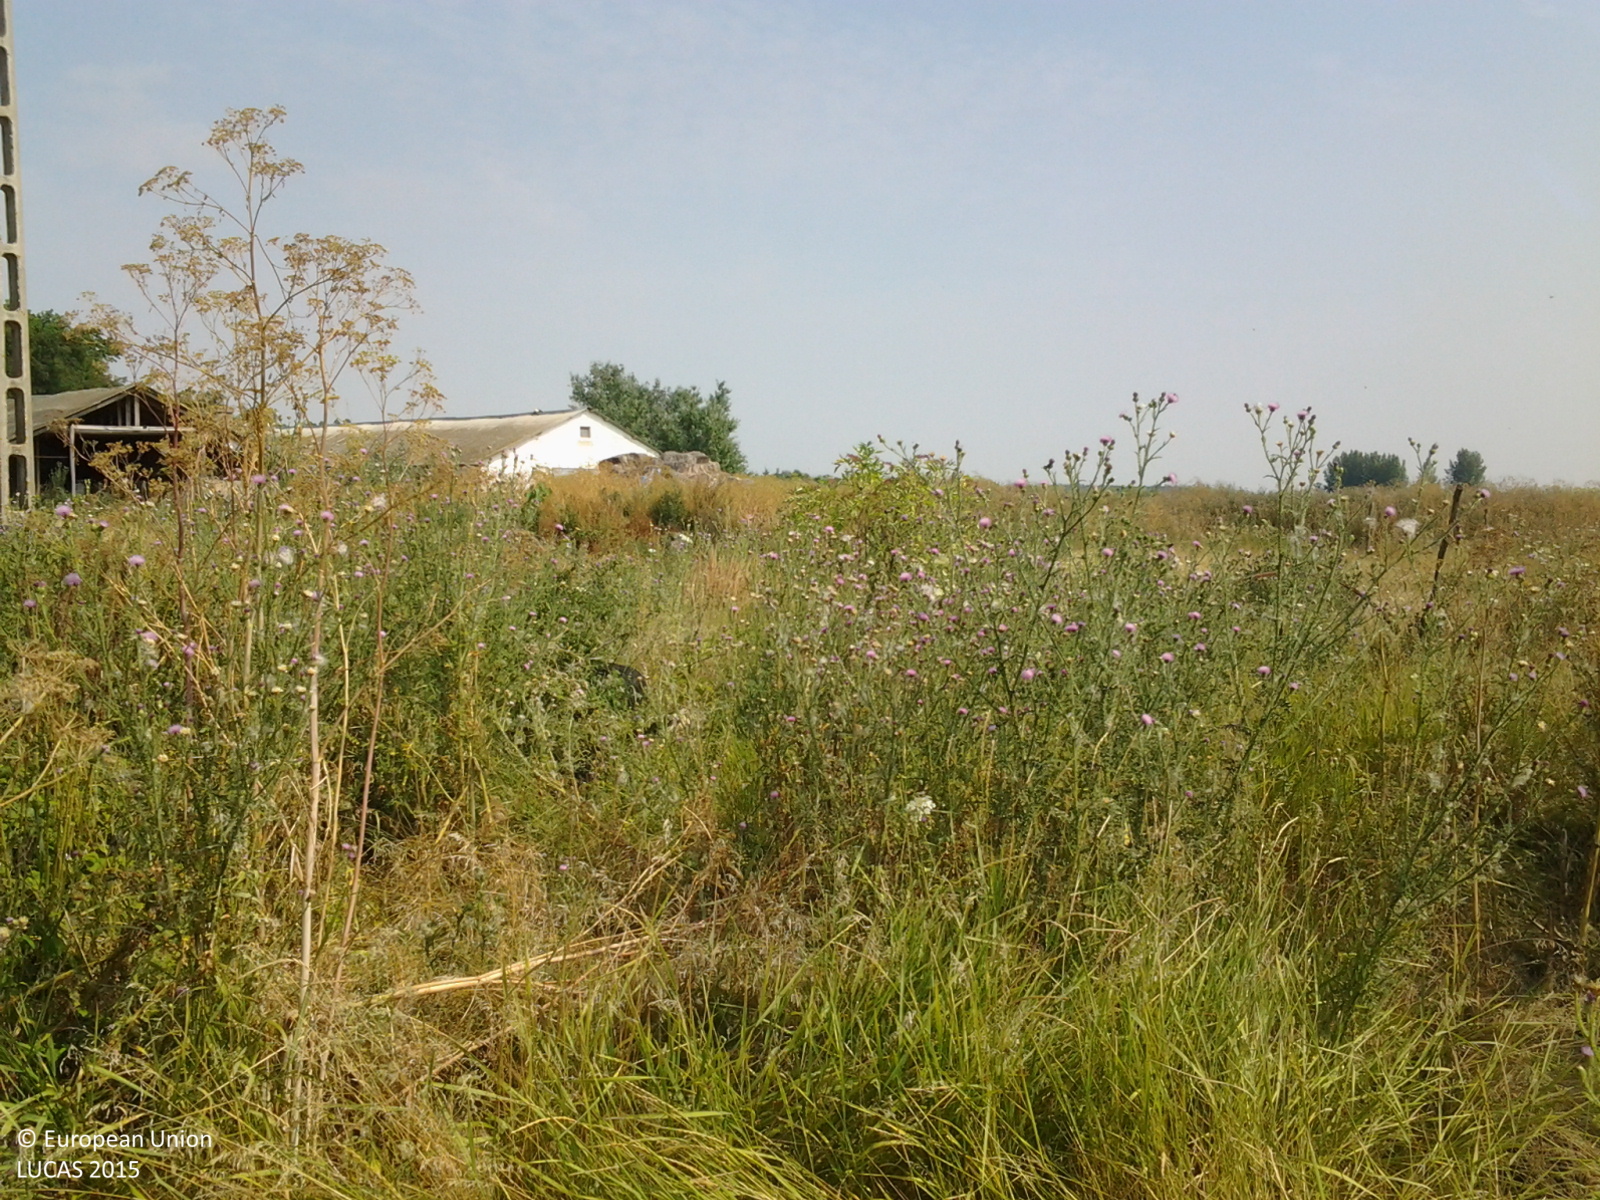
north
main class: Grassland
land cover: Grassland without tree/shrub cover
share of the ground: > 75 %
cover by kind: herbaceous plants 100 %
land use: Agriculture (excluding fallow land and kitchen gardens)
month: July
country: HU
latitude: 46.7916
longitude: 21.4226
